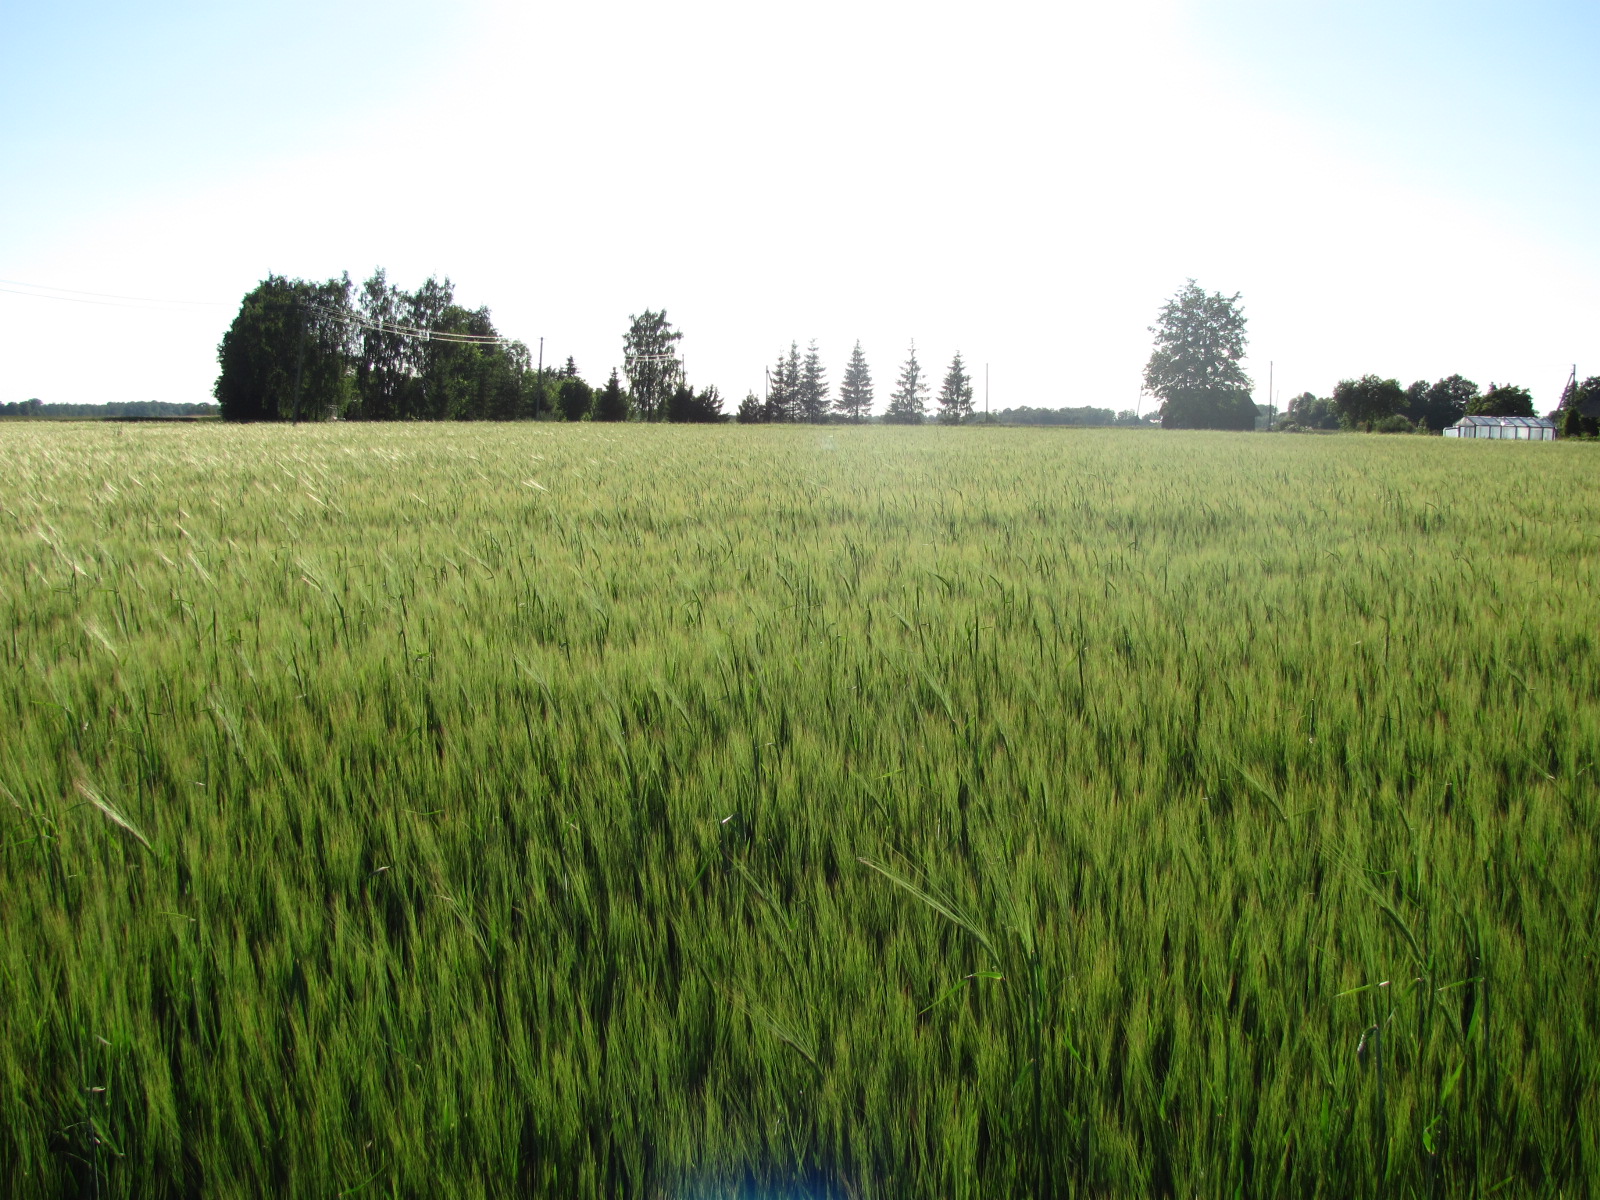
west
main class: Cropland
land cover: Barley
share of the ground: > 75 %
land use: Agriculture (excluding fallow land and kitchen gardens)
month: July
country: LV
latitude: 56.4192
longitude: 23.8453
